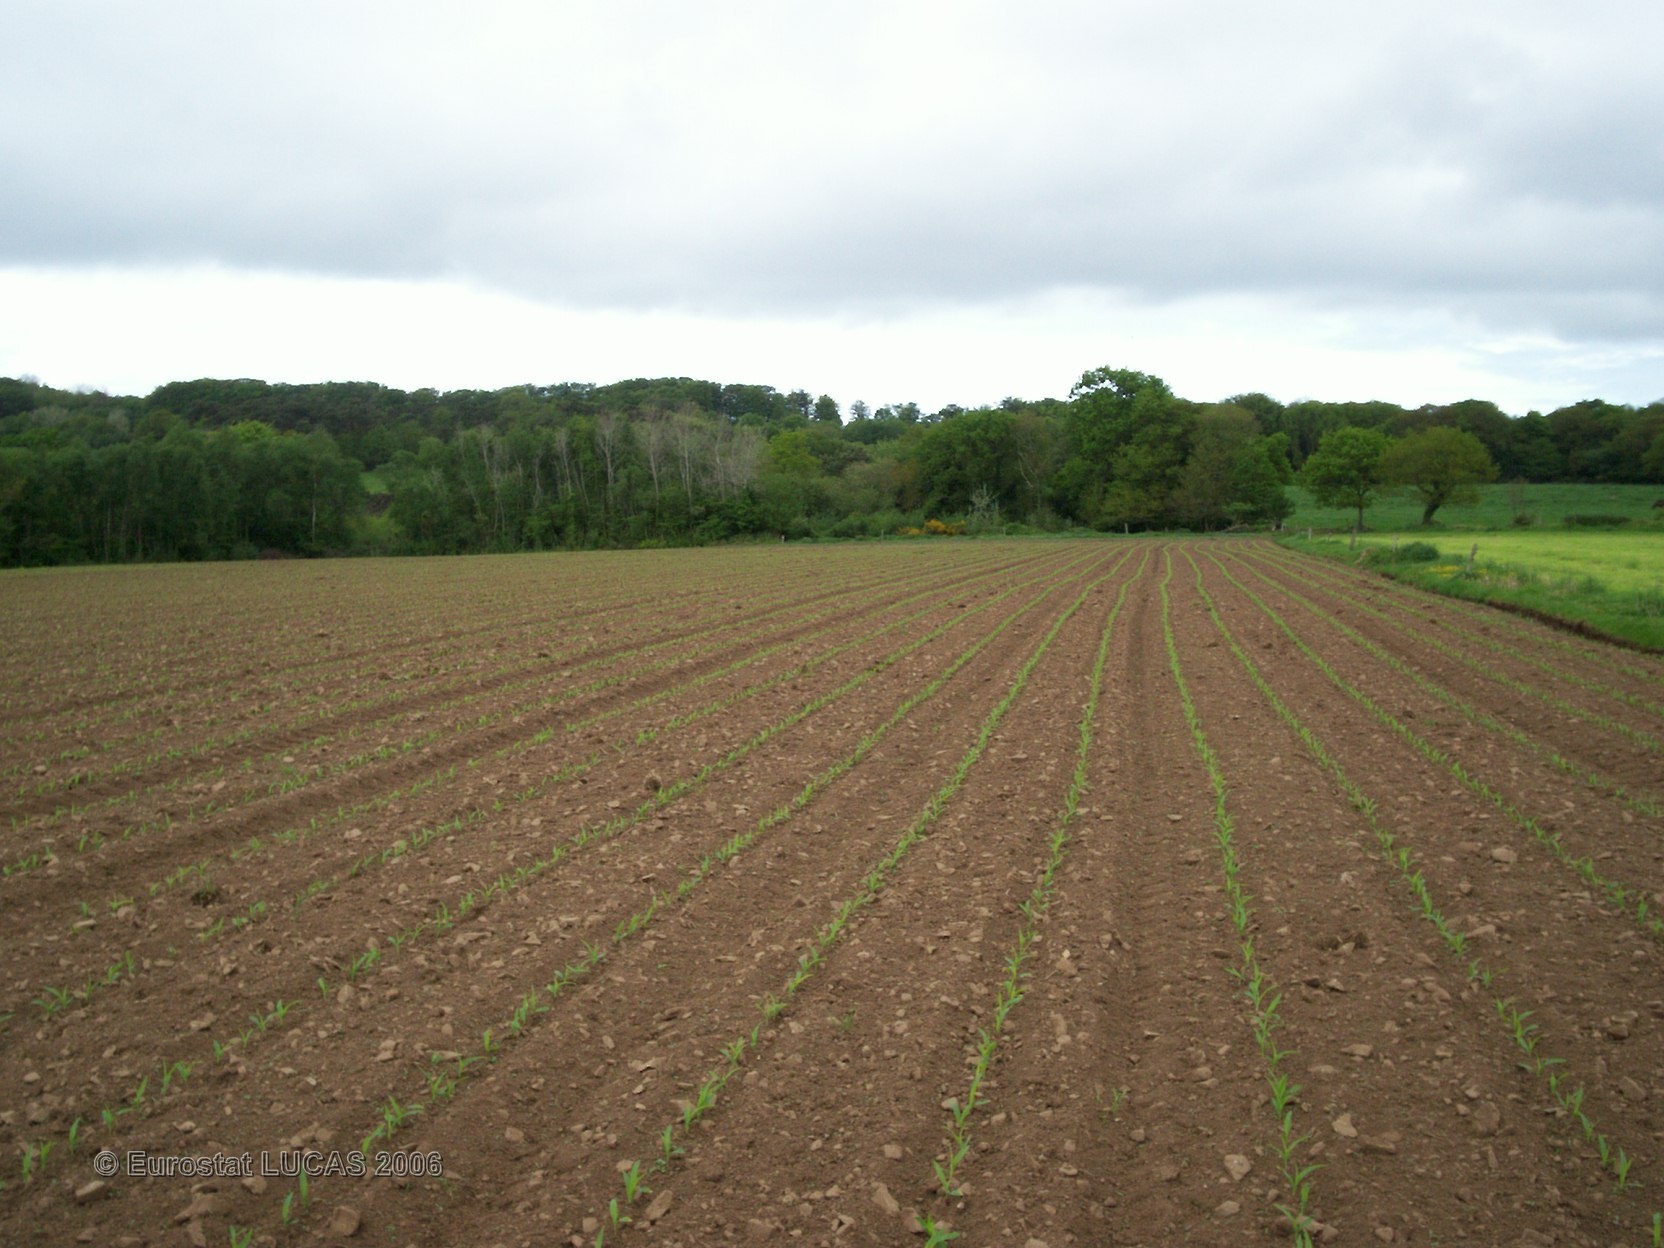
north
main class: Cropland
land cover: Maize
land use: Agriculture (excluding fallow land and kitchen gardens)
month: May
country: FR
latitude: 48.6168
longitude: -3.7440
